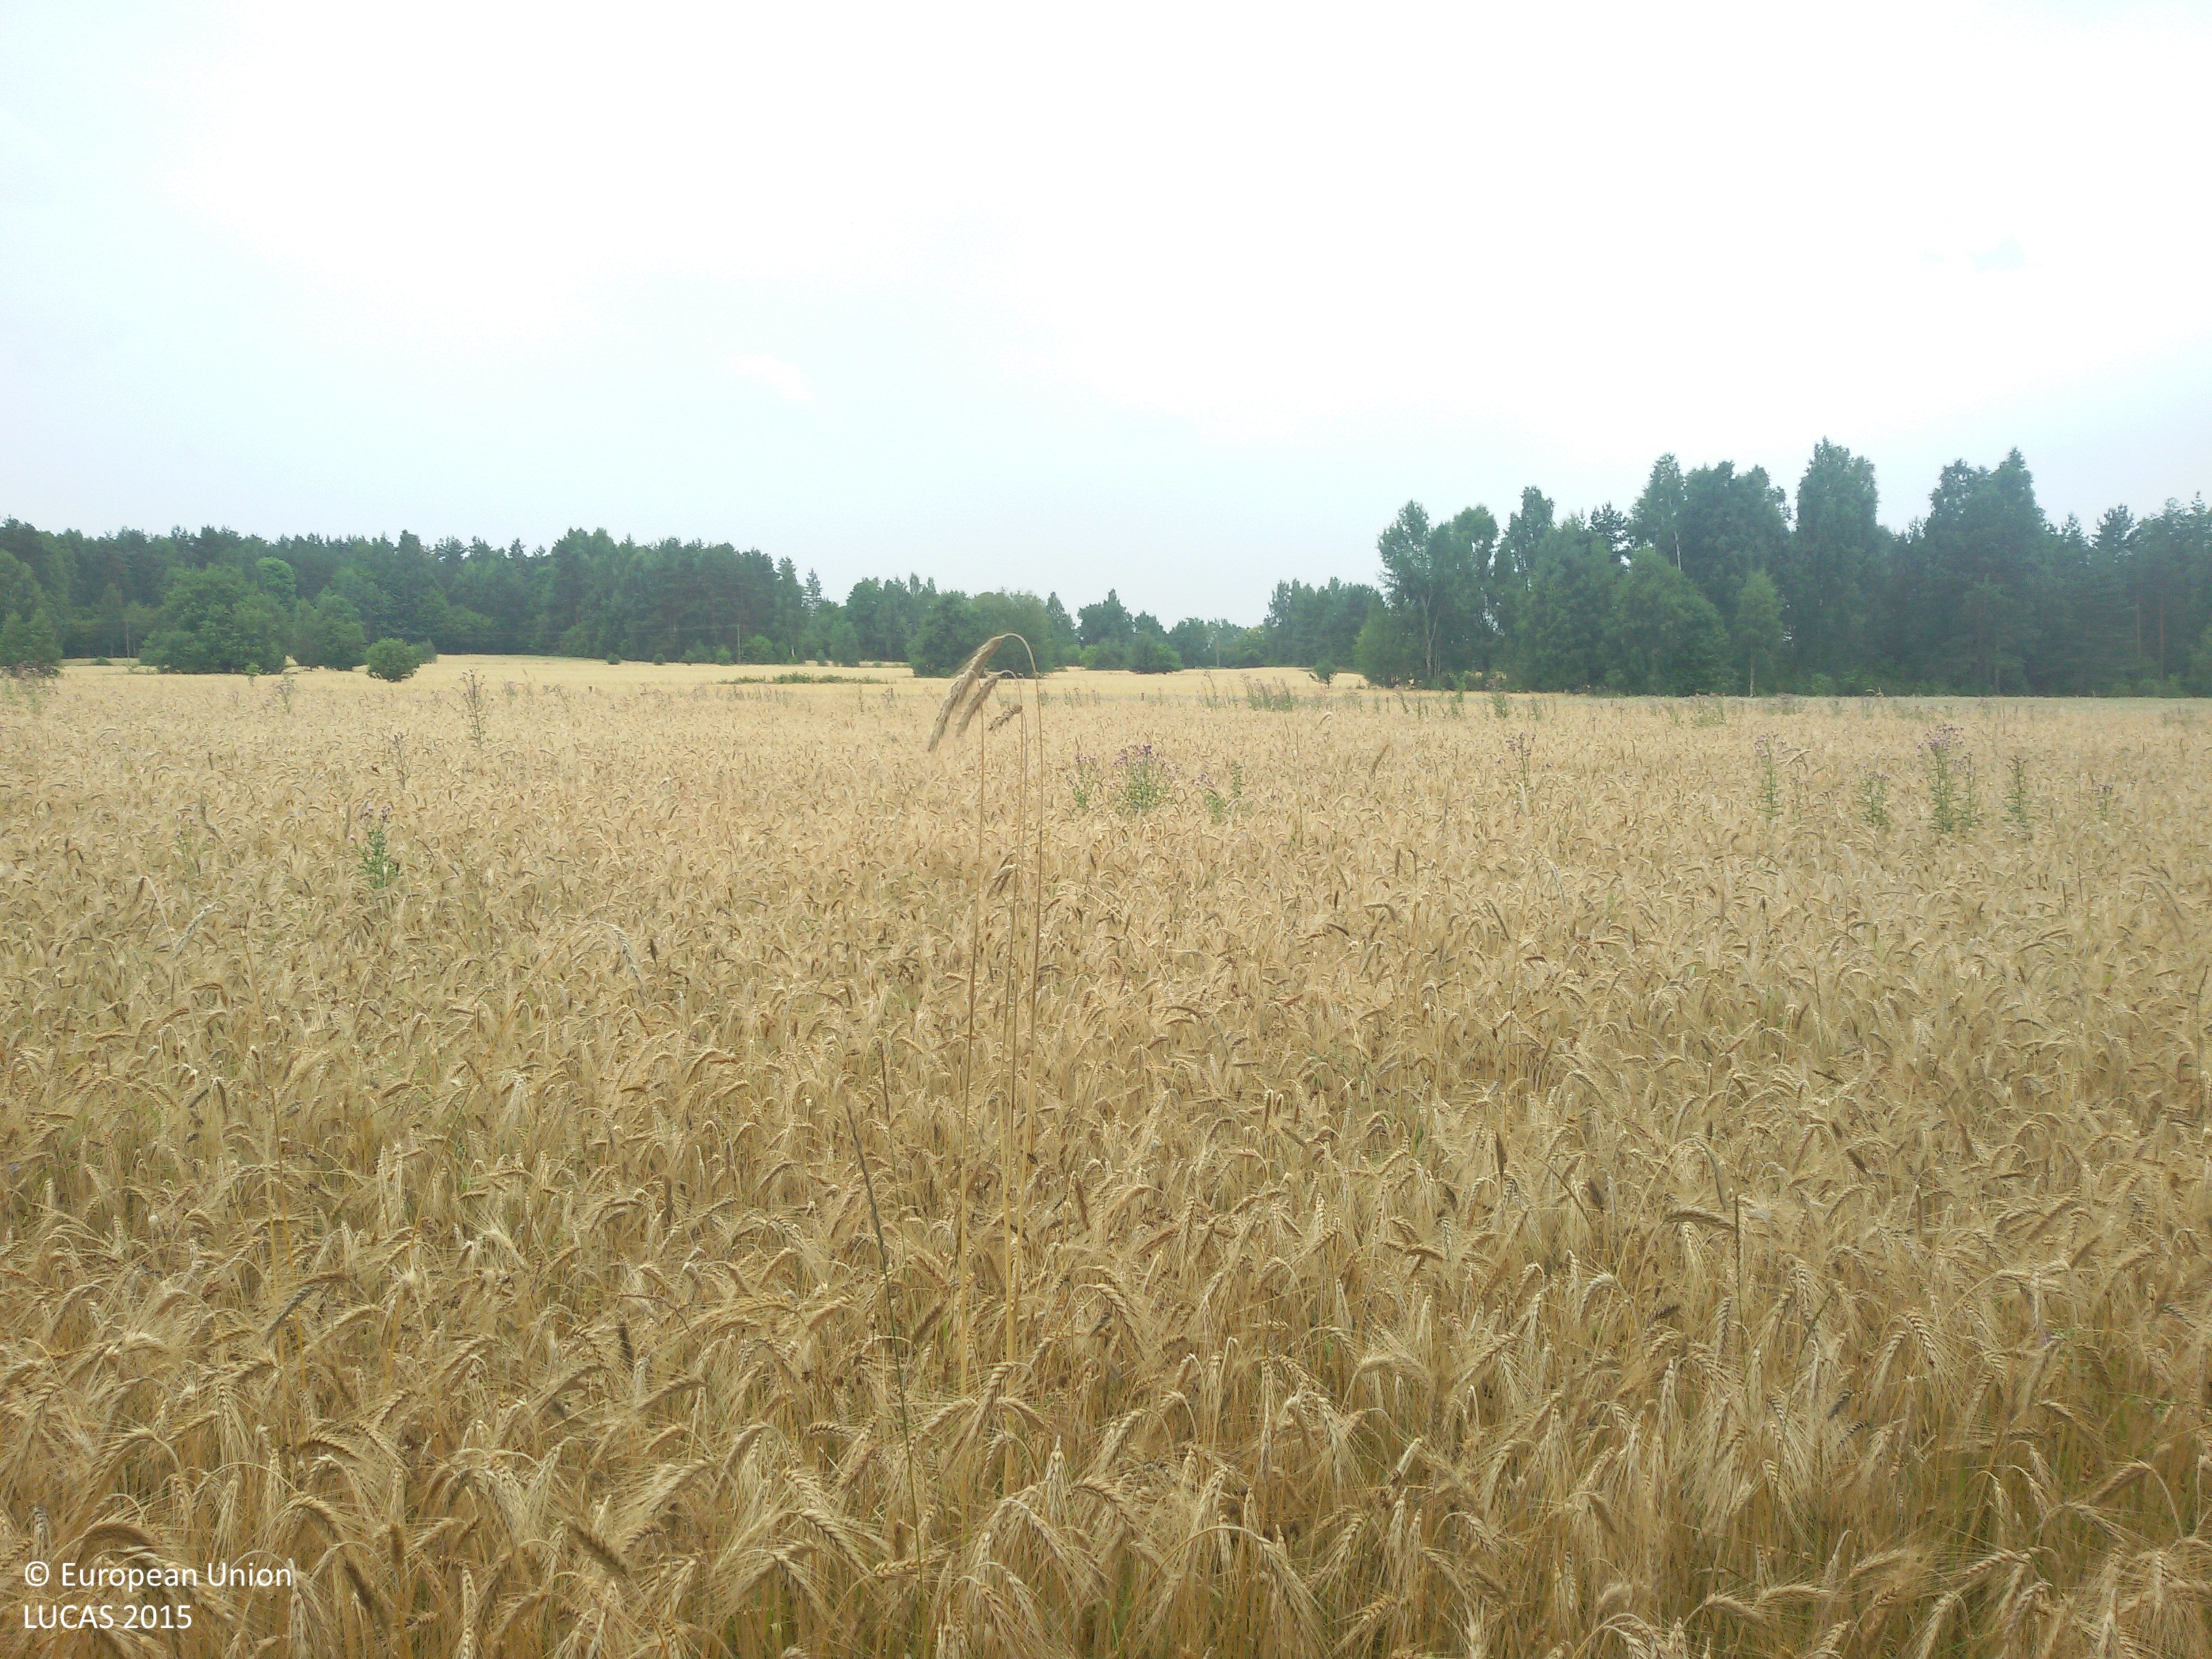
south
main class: Cropland
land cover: Triticale
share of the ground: > 75 %
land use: Agriculture (excluding fallow land and kitchen gardens)
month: July
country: PL
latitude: 53.4795
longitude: 23.5096
